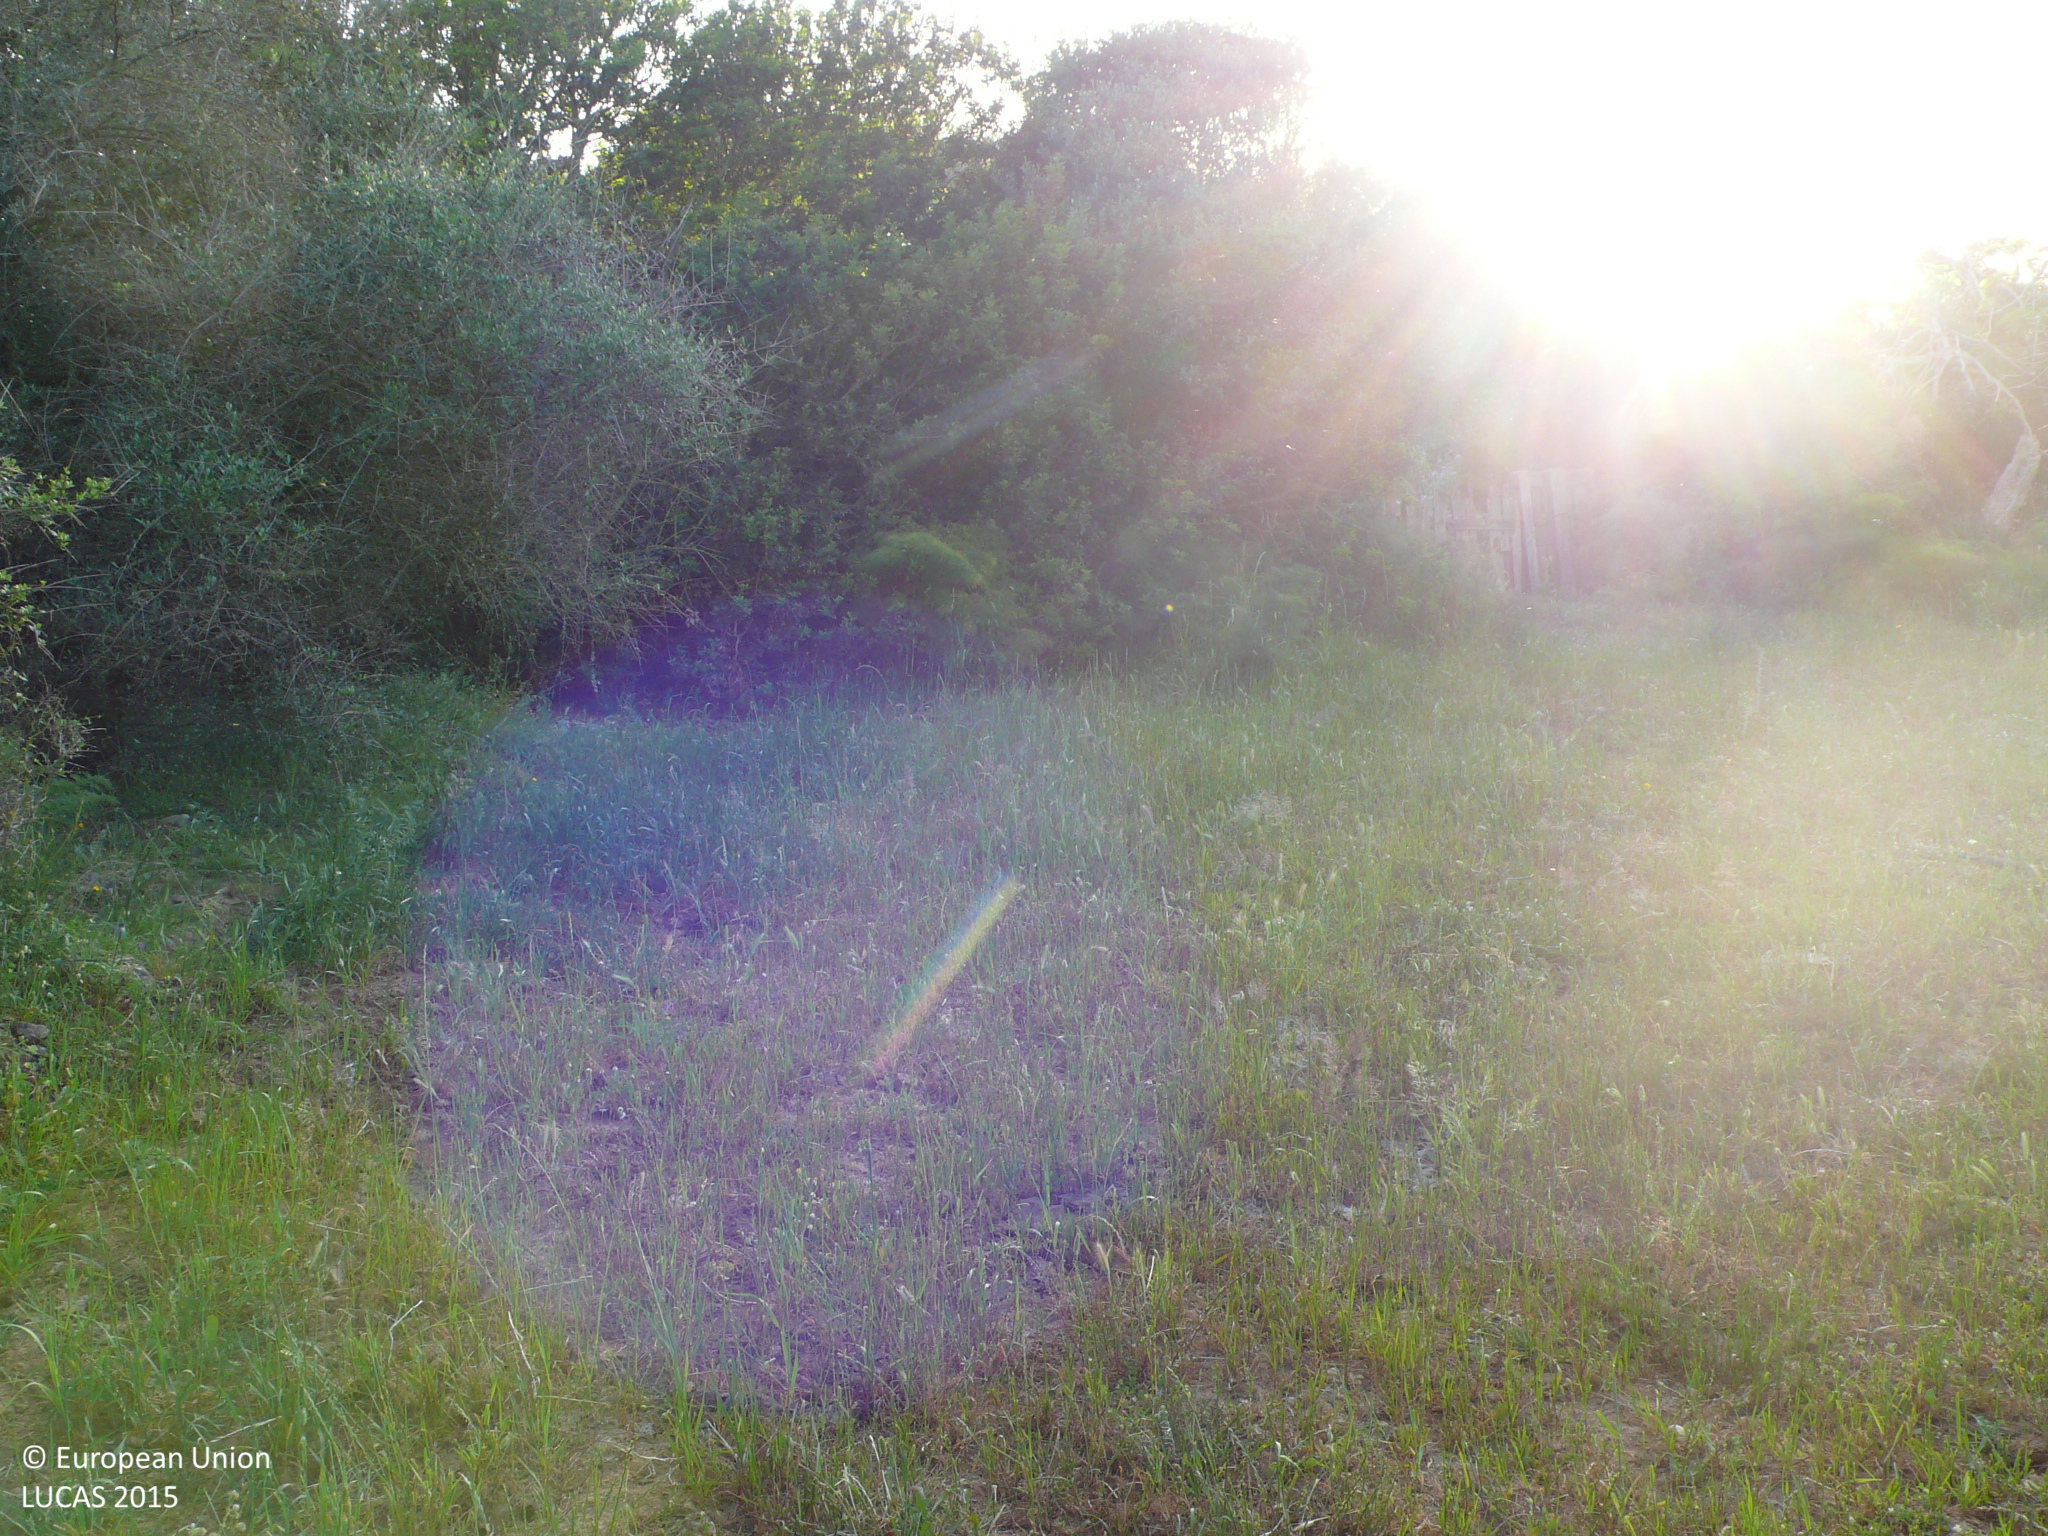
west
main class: Woodland
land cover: Broadleaved woodland
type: broadleaved evergreen forest
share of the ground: 50 - 75 %
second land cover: Grassland without tree/shrub cover
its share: > 75 %
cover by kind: broadleaved forest trees 60 %, shrubs 20 %, herbaceous plants 20 %
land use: Forestry
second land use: Agriculture (excluding fallow land and kitchen gardens)
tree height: > 5 m
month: May
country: ES
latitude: 39.9135
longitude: 4.1885
